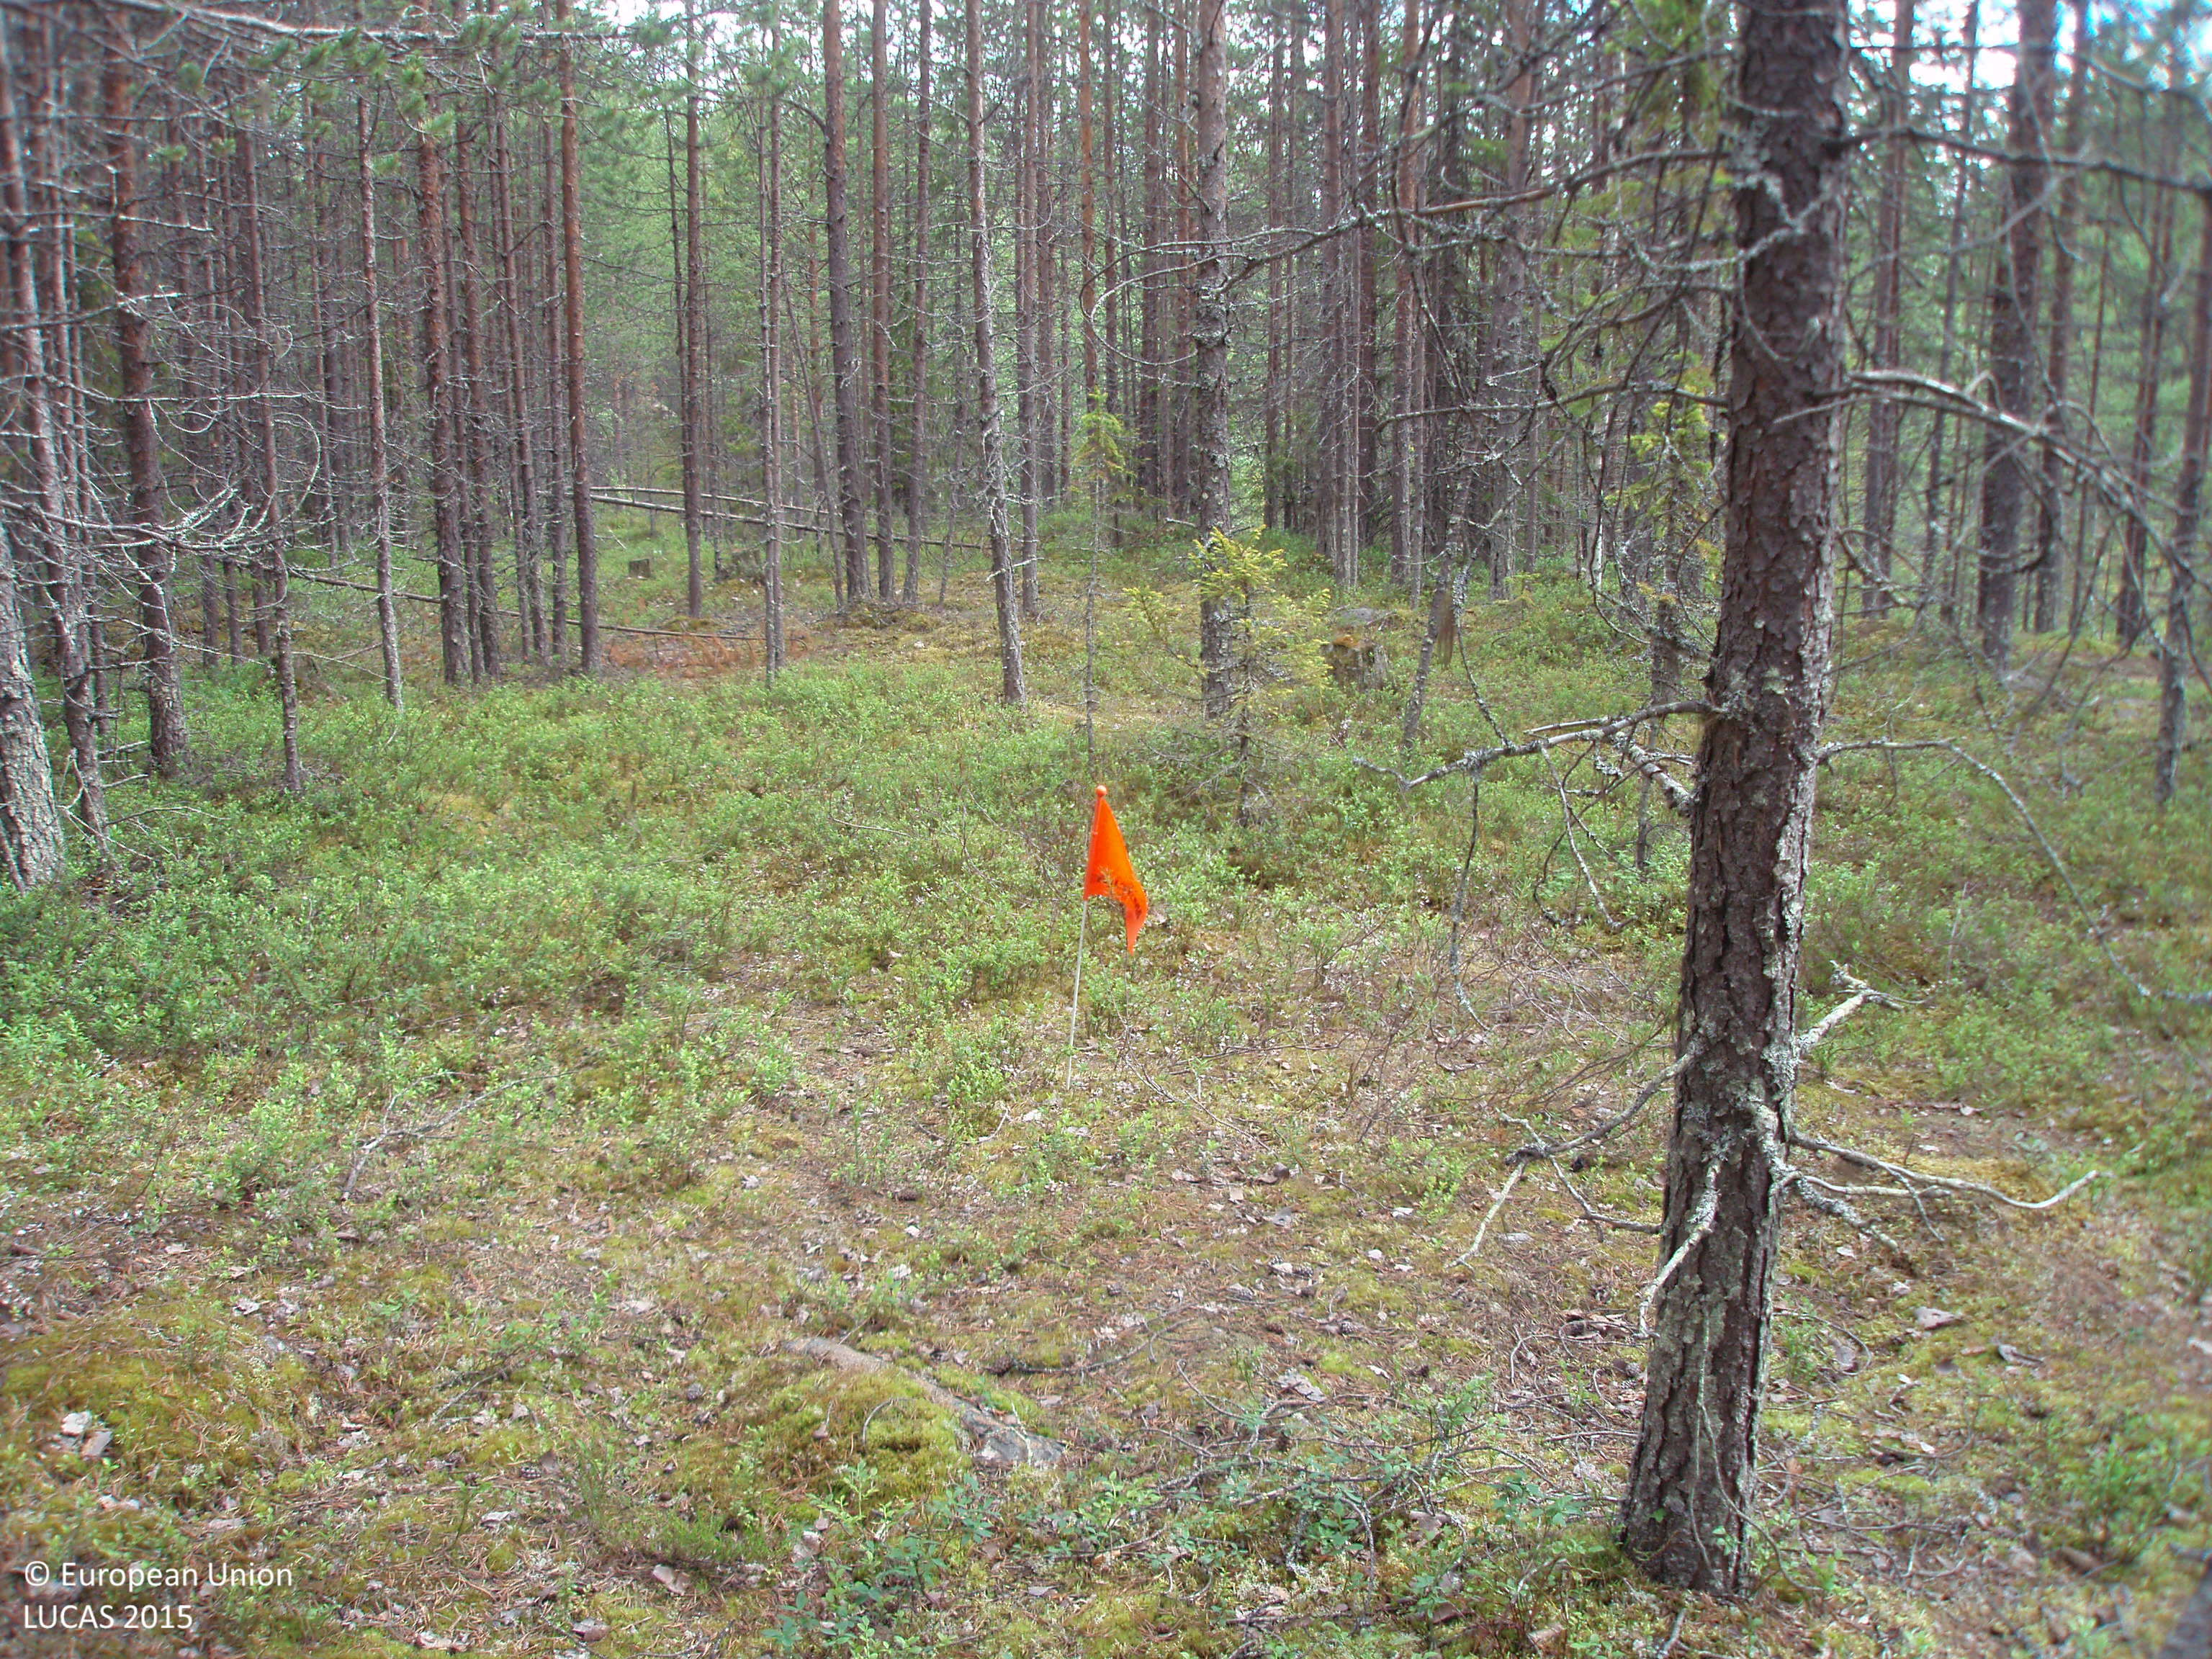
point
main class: Woodland
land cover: Pine dominated coniferous woodland
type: boreal forest
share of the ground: > 75 %
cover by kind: coniferous forest trees 70 %, shrubs 20 %, broadleaved forest trees 5 %, lichens and mosses 5 %
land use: Forestry
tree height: > 5 m
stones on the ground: 10 - 25 %
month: July
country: FI
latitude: 66.8945
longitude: 28.4282
